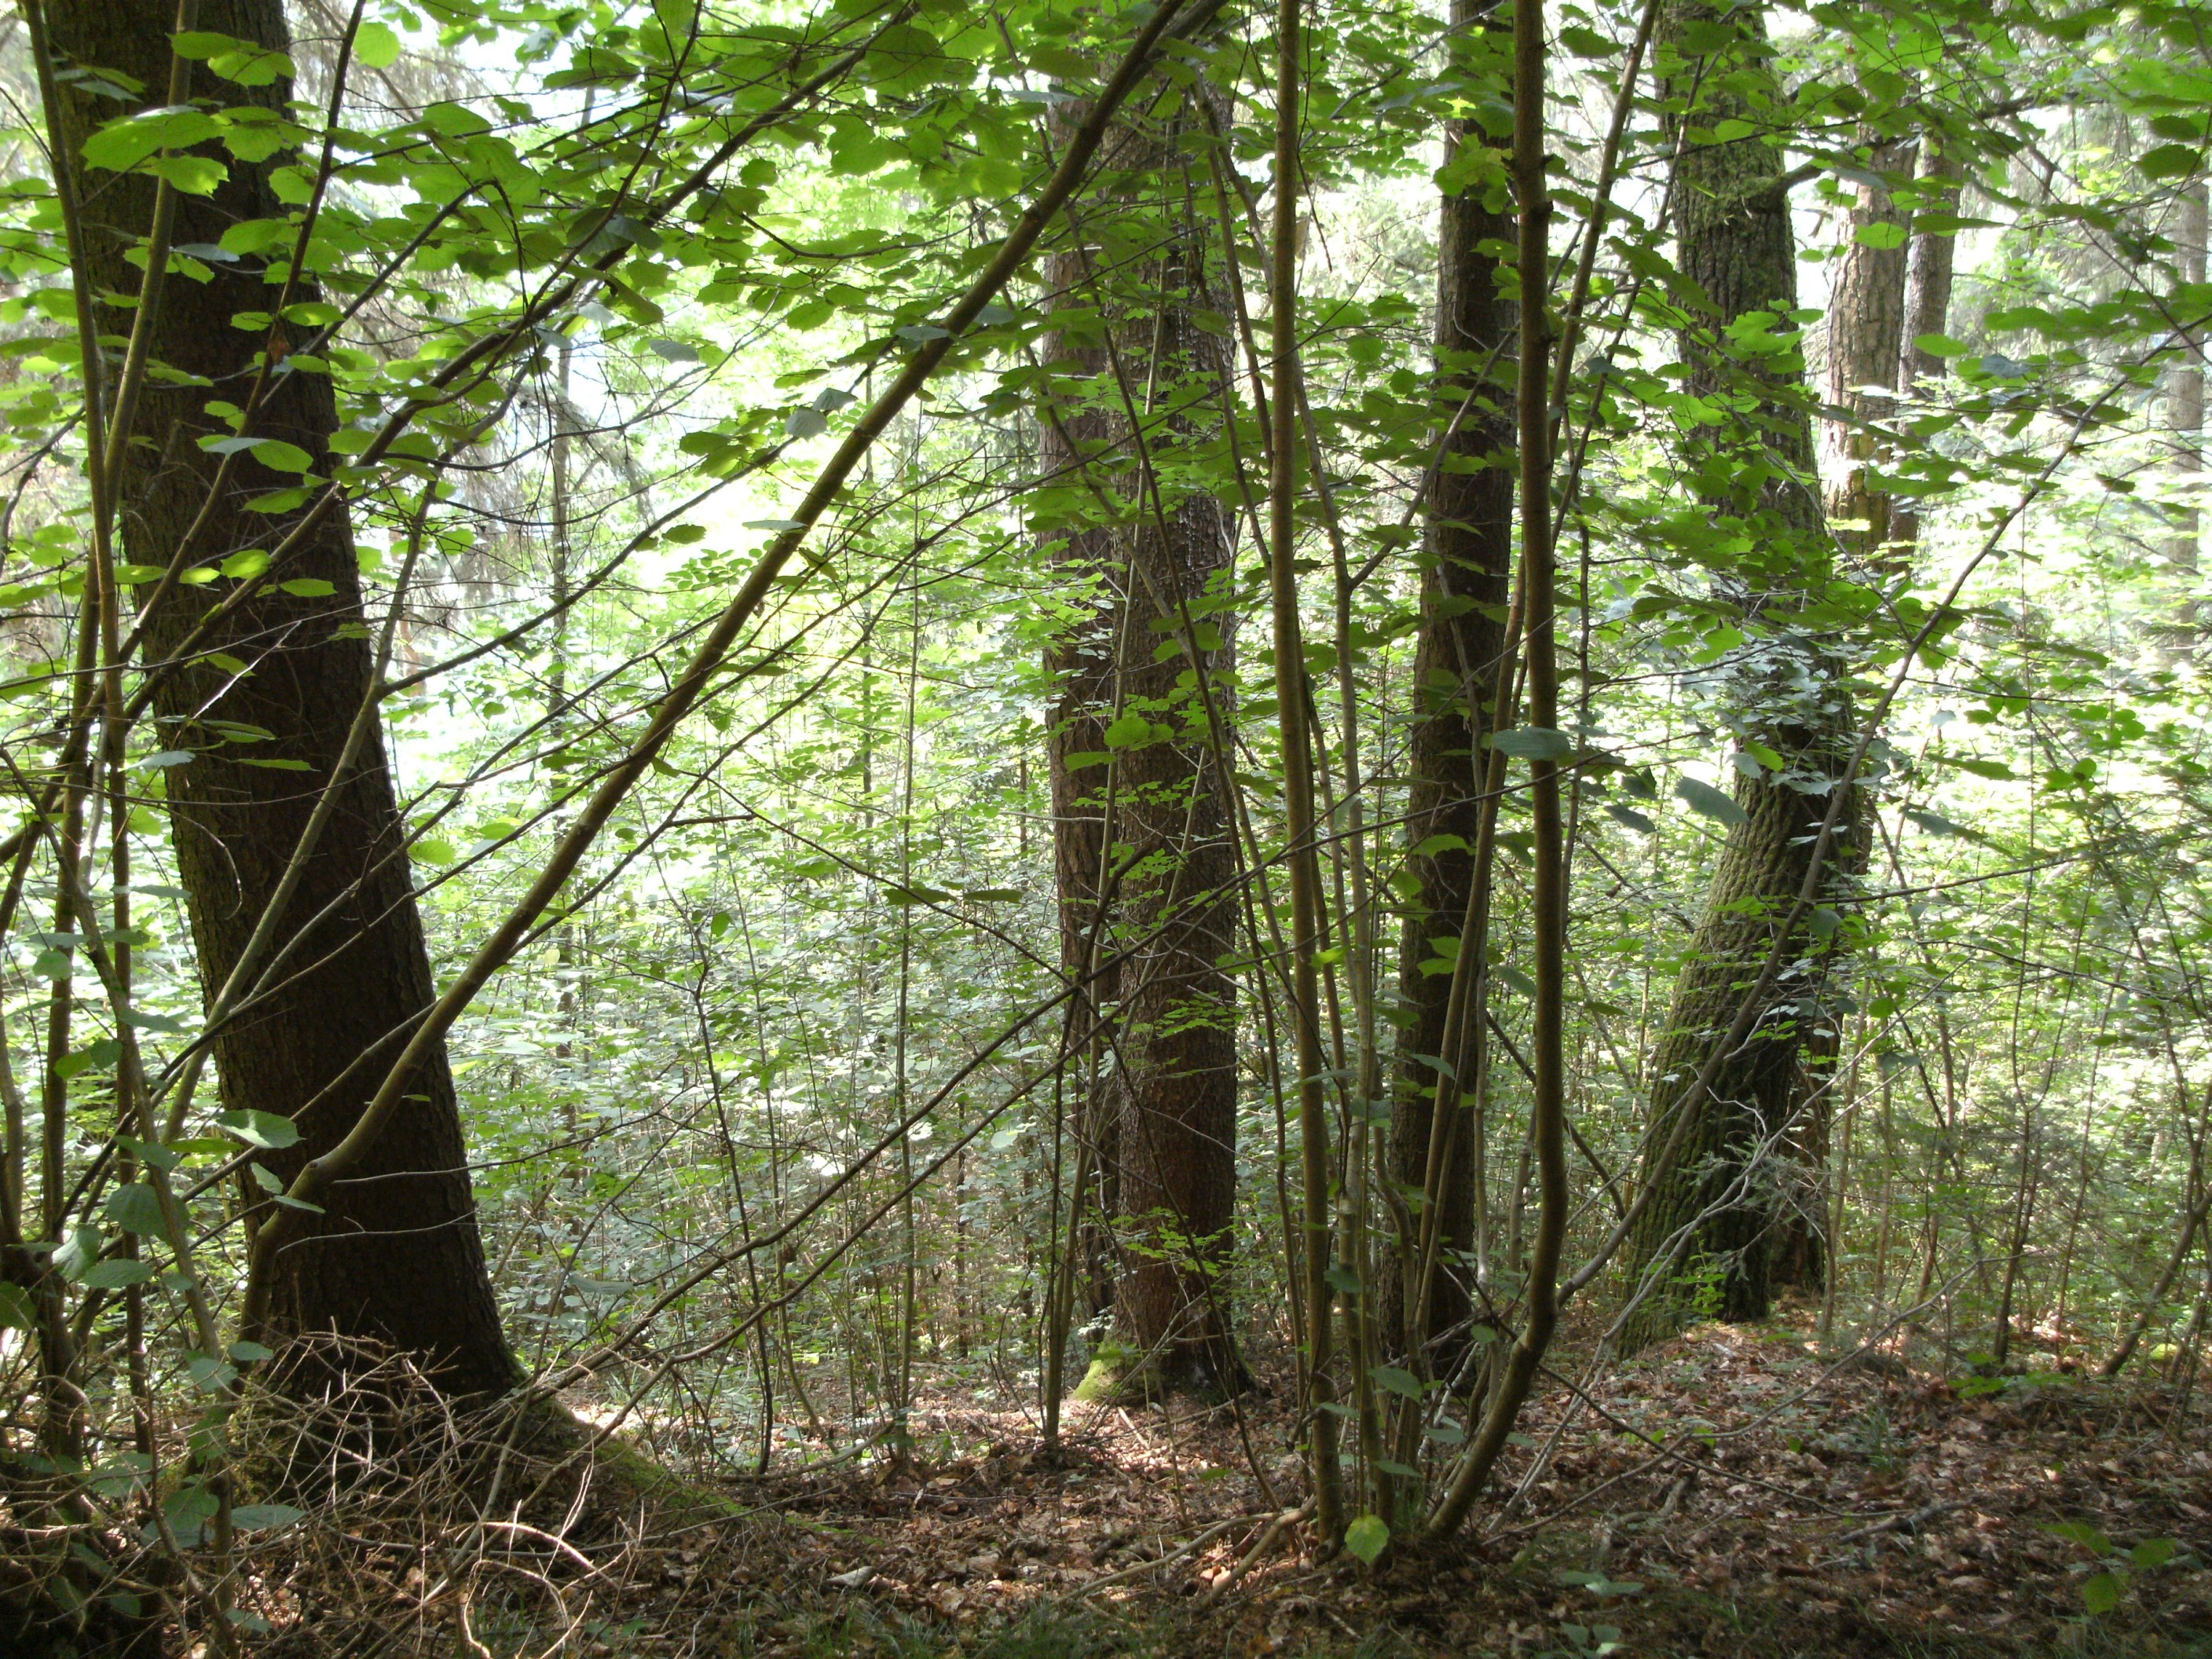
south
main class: Woodland
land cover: Spruce dominated coniferous woodland
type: hemiboreal forest and nemoral coniferous forest and mixed broadleaved-coniferous forest
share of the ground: 50 - 75 %
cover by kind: coniferous forest trees 60 %, shrubs 20 %, broadleaved forest trees 10 %, herbaceous plants 5 %, unconsolidated bare surface 5 %
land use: Forestry
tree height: > 5 m
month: July
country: AT
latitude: 46.6540
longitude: 14.8983
